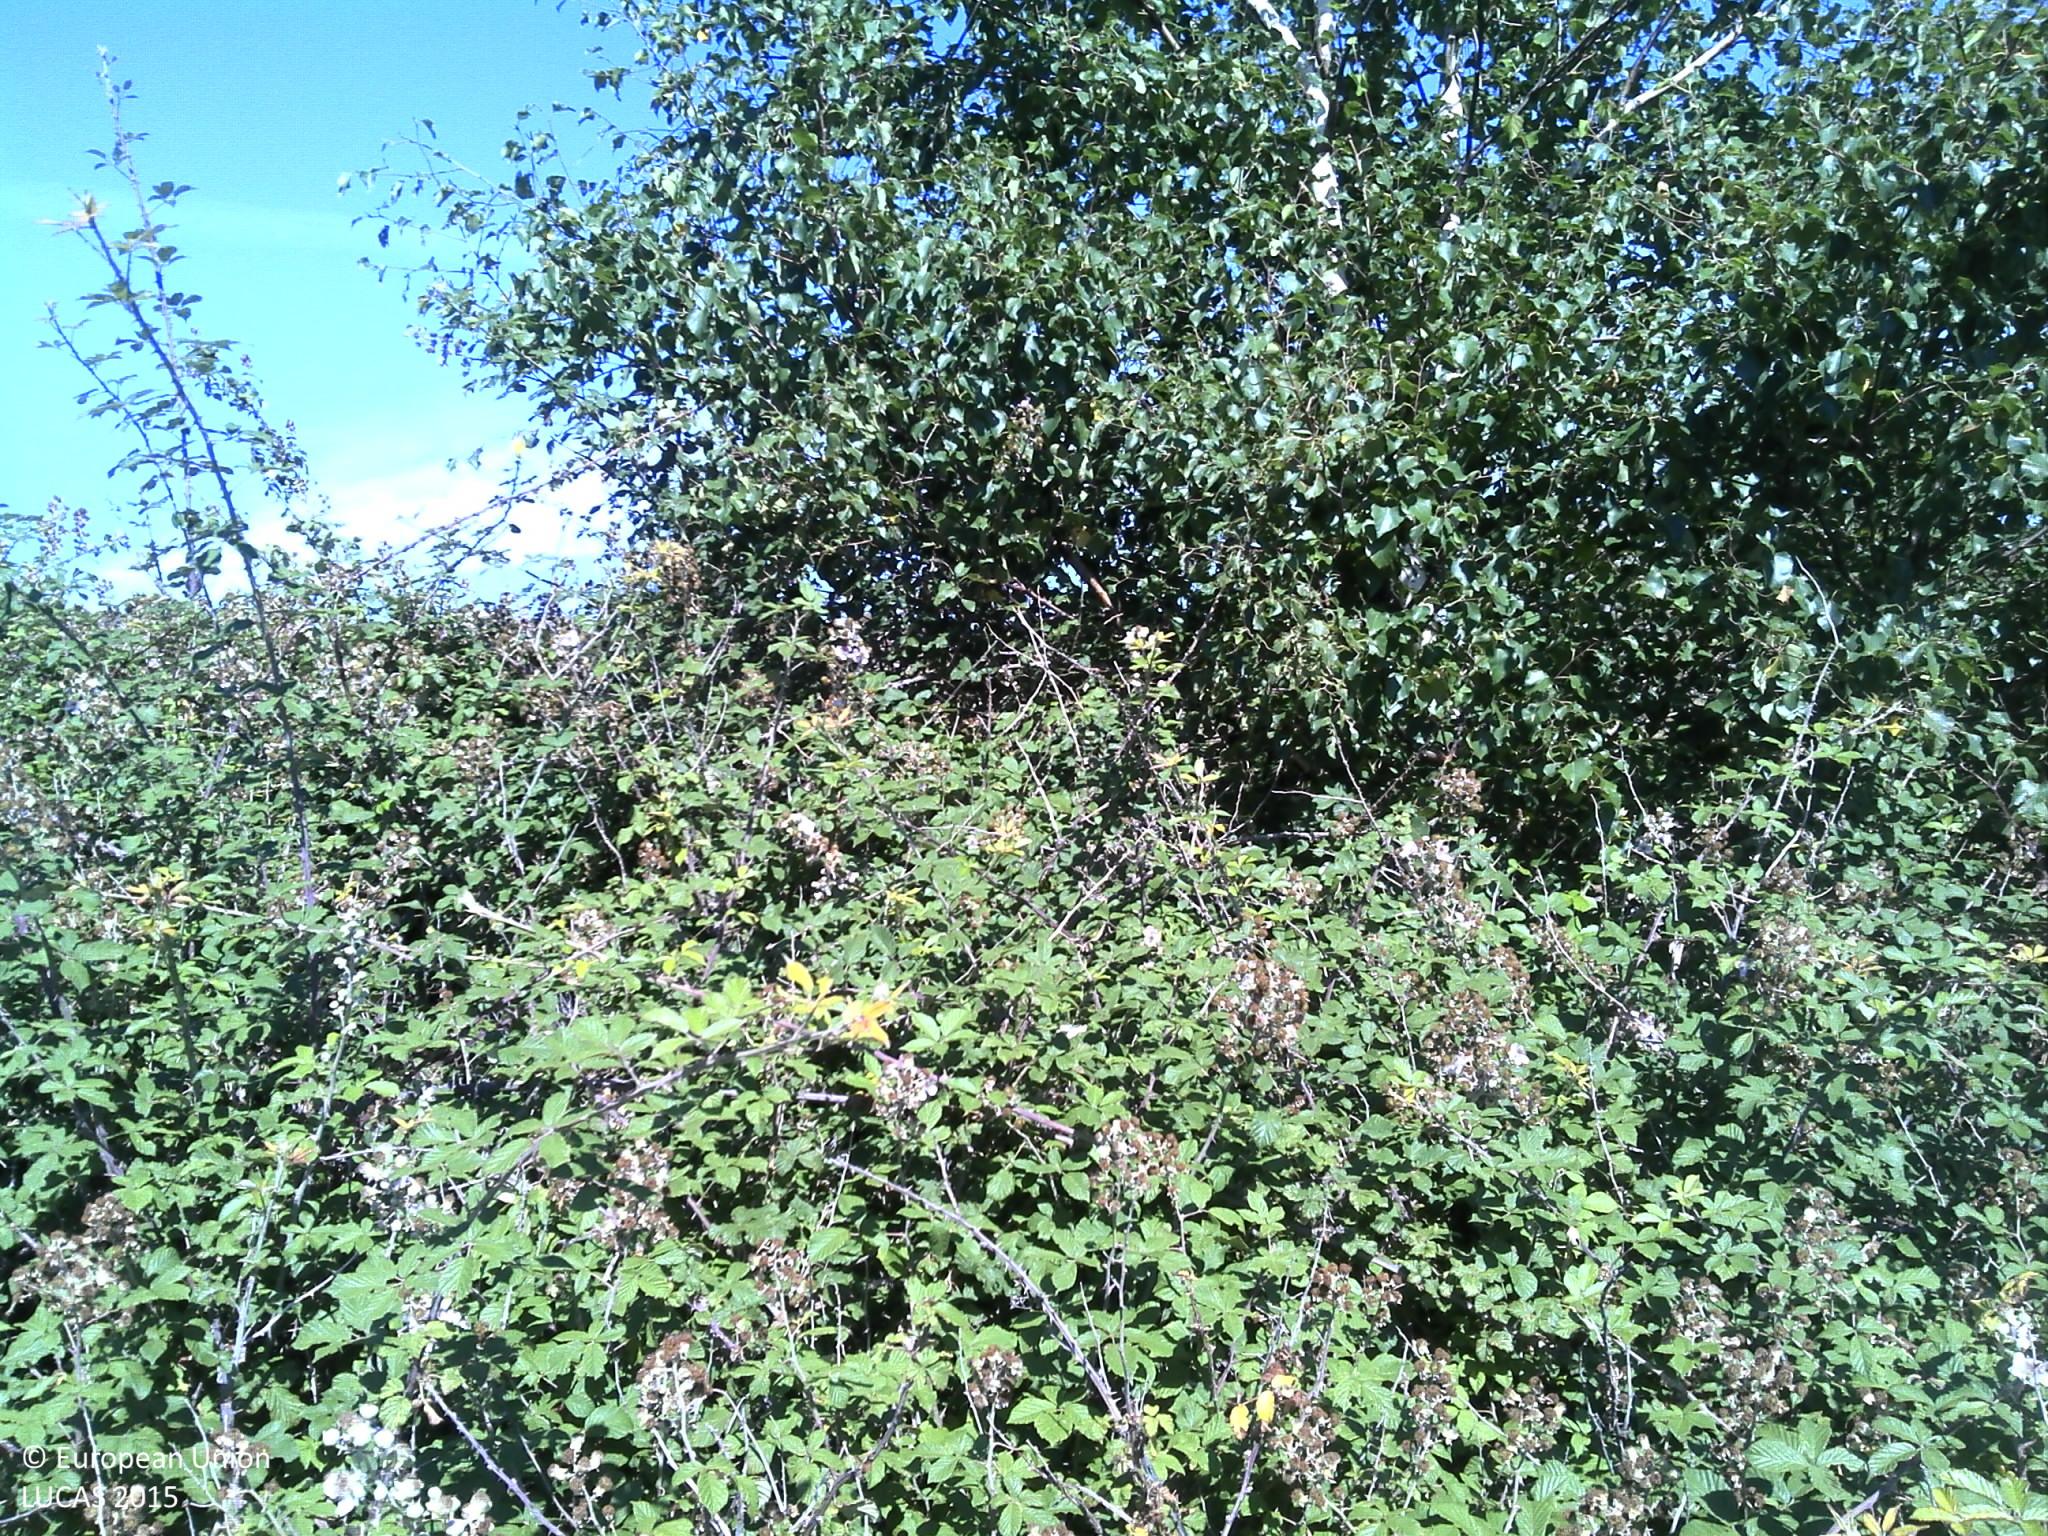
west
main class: Shrubland
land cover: Shrubland without tree cover
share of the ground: > 75 %
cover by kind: shrubs 90 %, consolidated bare surface 5 %, unconsolidated bare surface 5 %
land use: Agriculture (excluding fallow land and kitchen gardens)
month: July
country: PT
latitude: 41.4472
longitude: -7.8141
